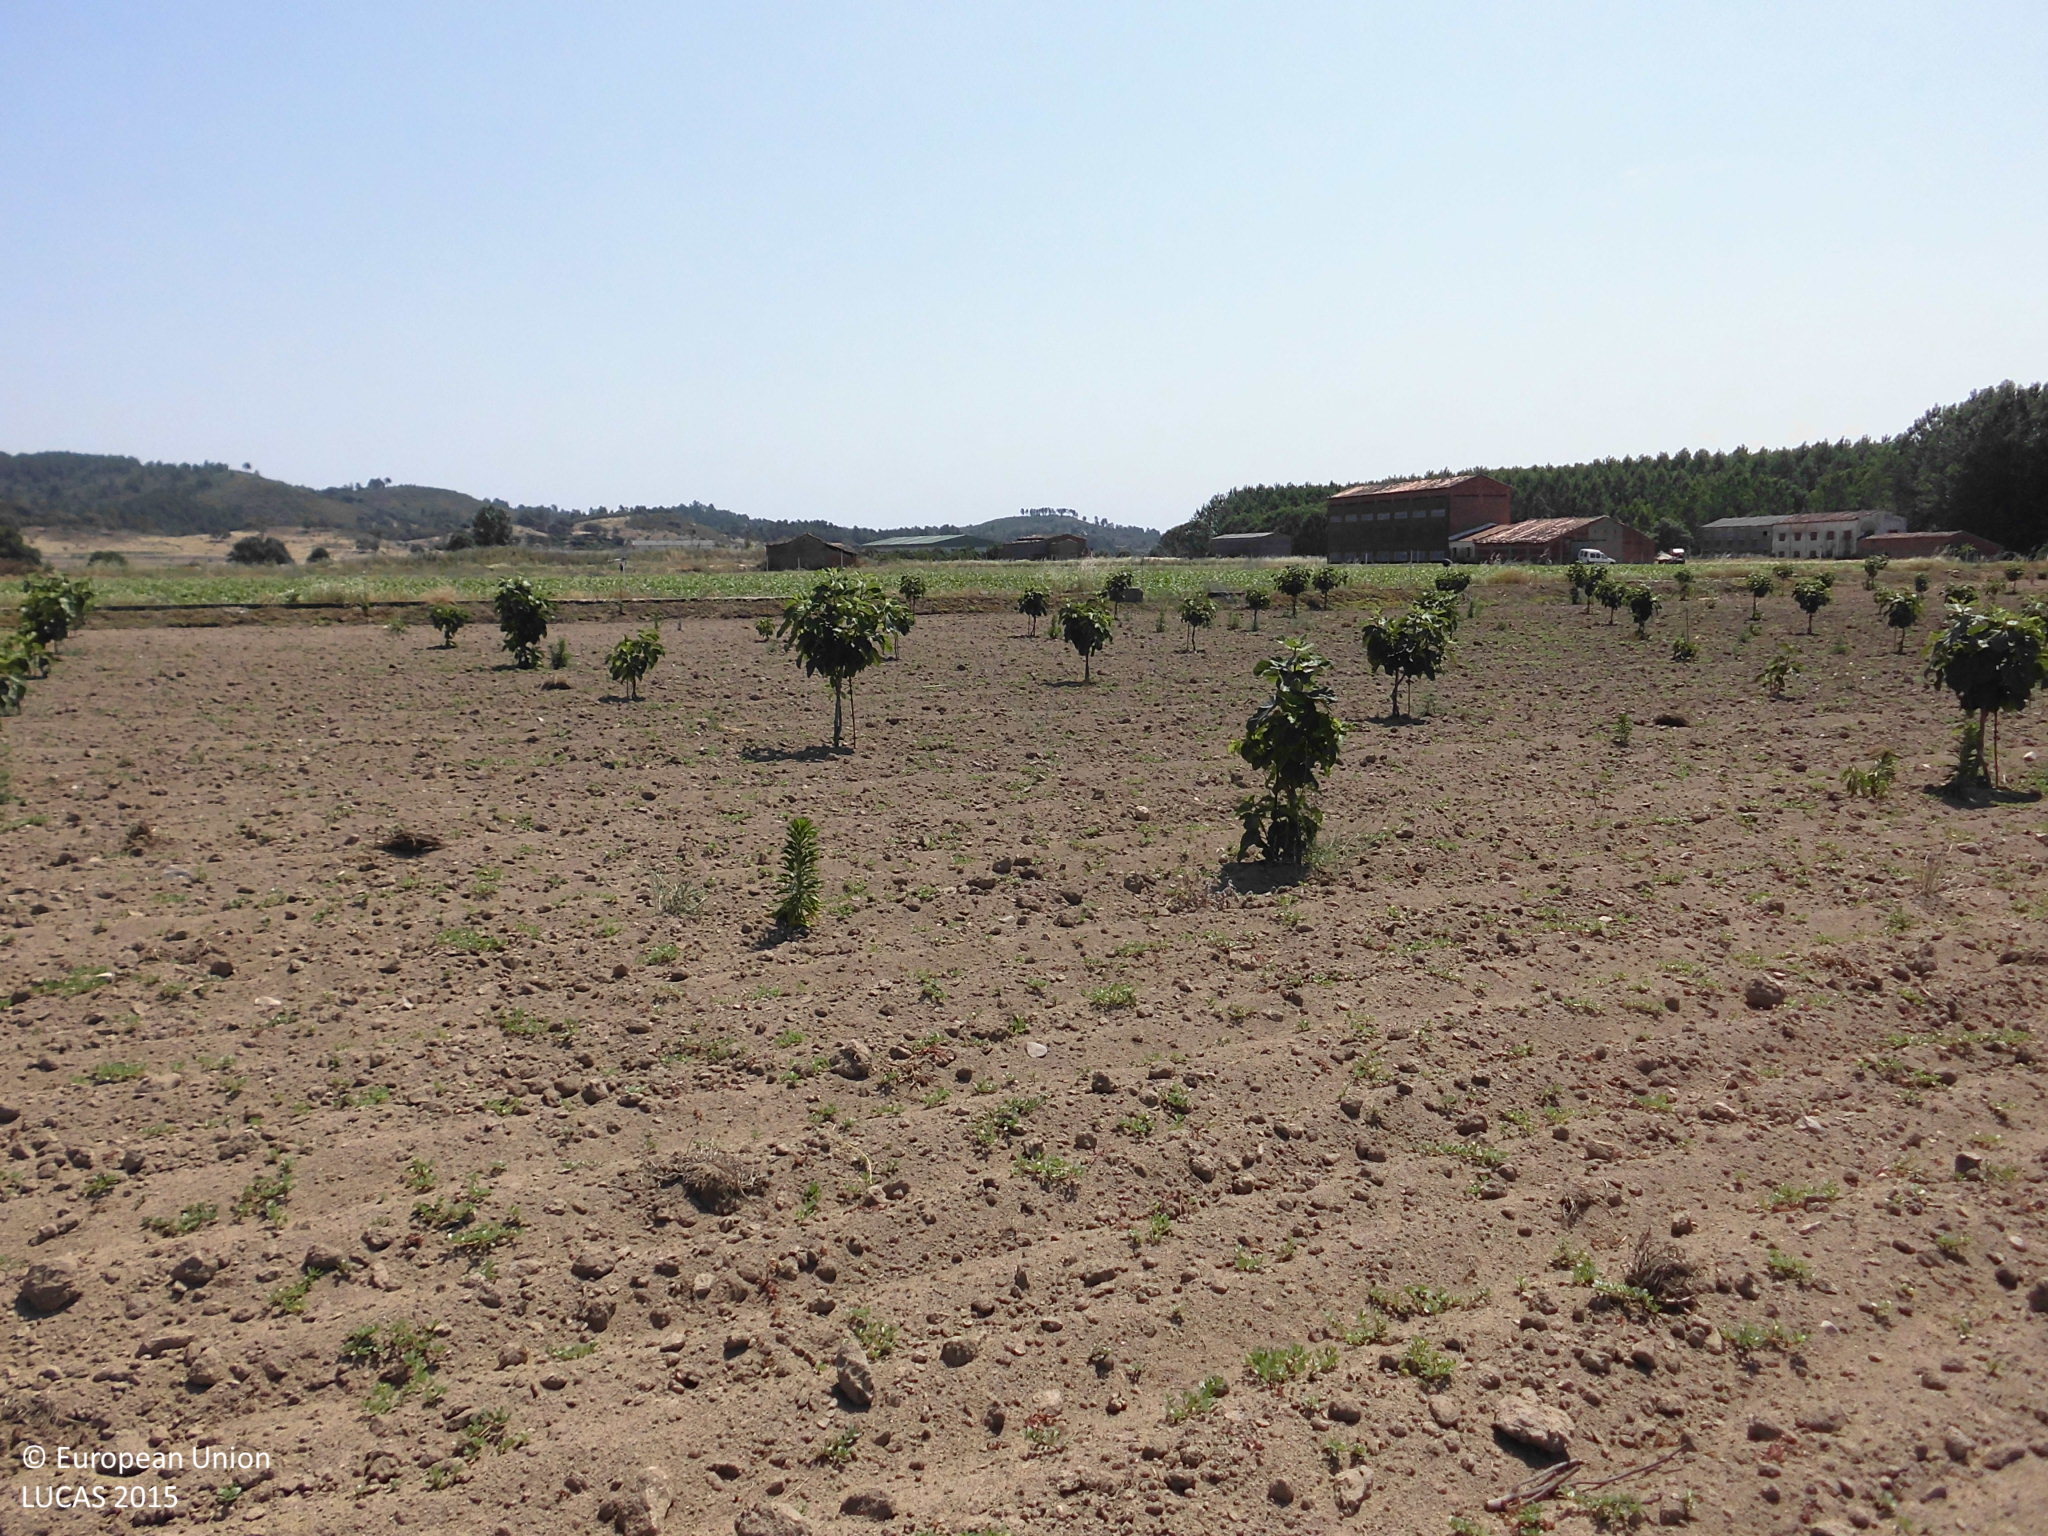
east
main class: Cropland
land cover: Other fruit trees and berries
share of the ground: < 10 %
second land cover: Other bare soil
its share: > 75 %
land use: Agriculture (excluding fallow land and kitchen gardens)
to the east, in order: Other fruit trees and berries; Other bare soil; Other fruit trees and berries; Grass margins; Tobacco; Grass margins; Tracks; Grass margins; Tobacco; Ditches and canals; Shruby margins; Other fresh vegetables; Other bare soil
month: June
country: ES
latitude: 40.0742
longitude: -5.5041
